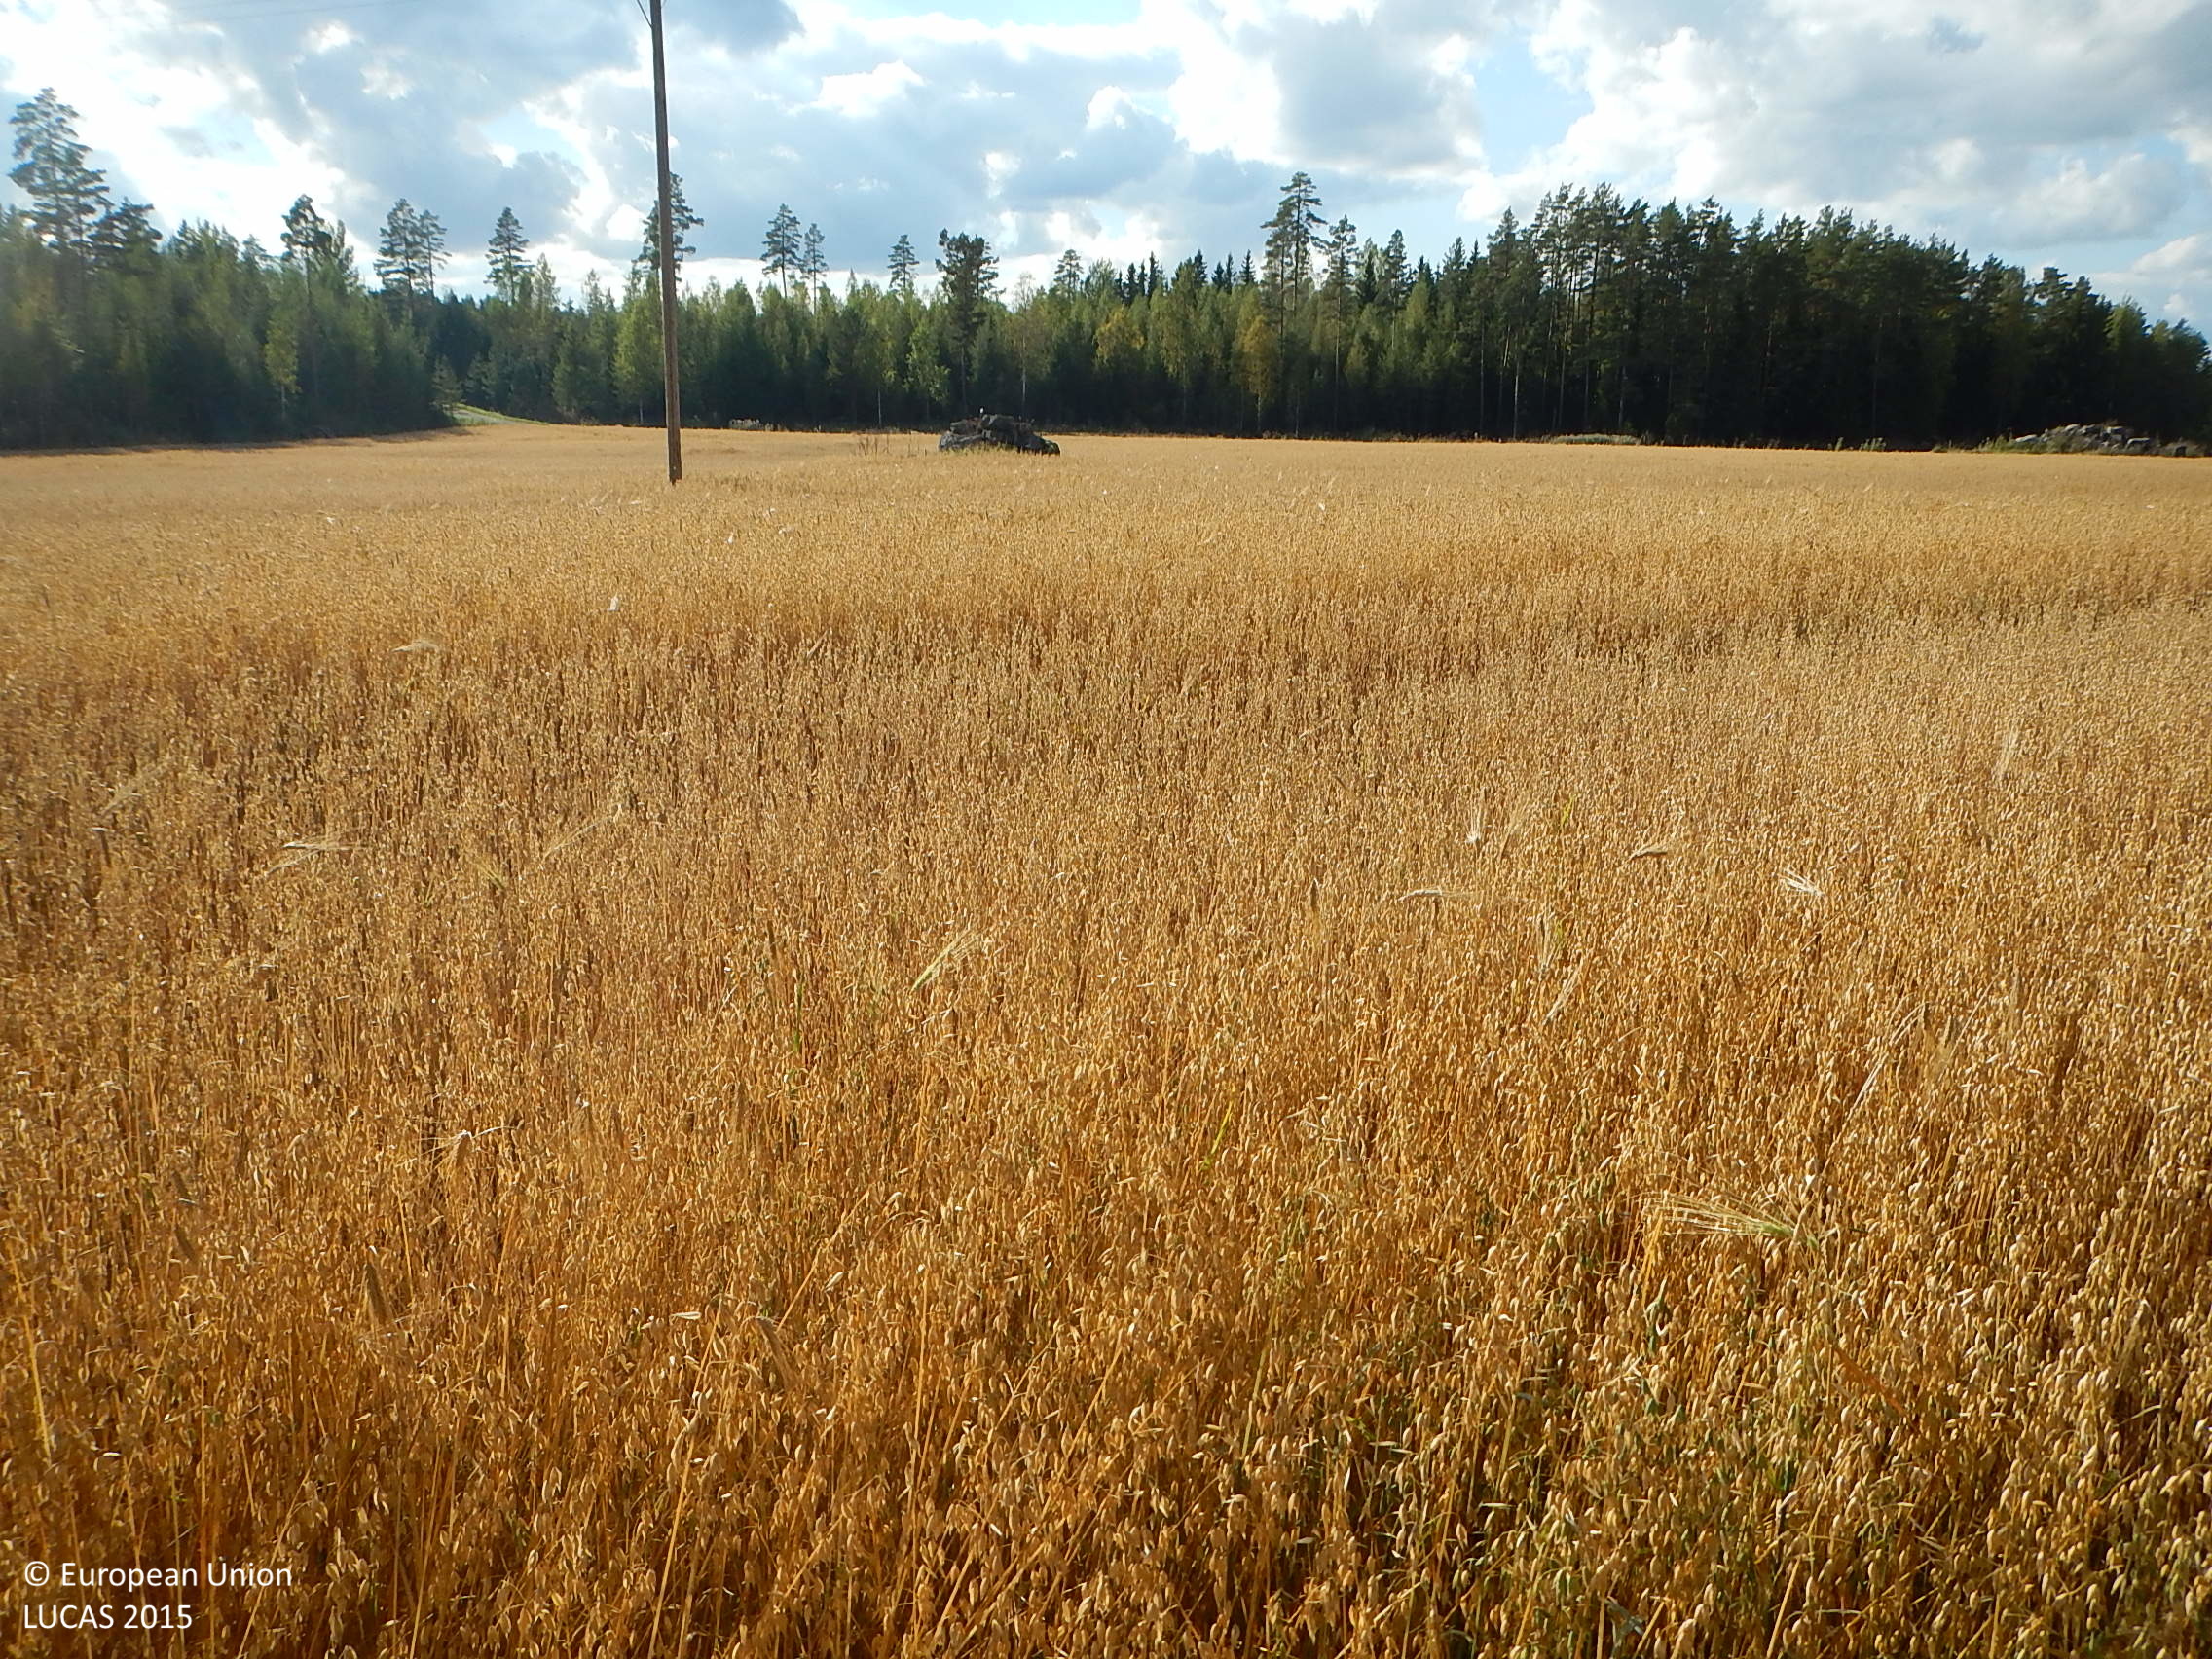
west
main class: Cropland
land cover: Oats
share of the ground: > 75 %
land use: Agriculture (excluding fallow land and kitchen gardens)
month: September
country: FI
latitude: 61.5387
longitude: 22.3058
